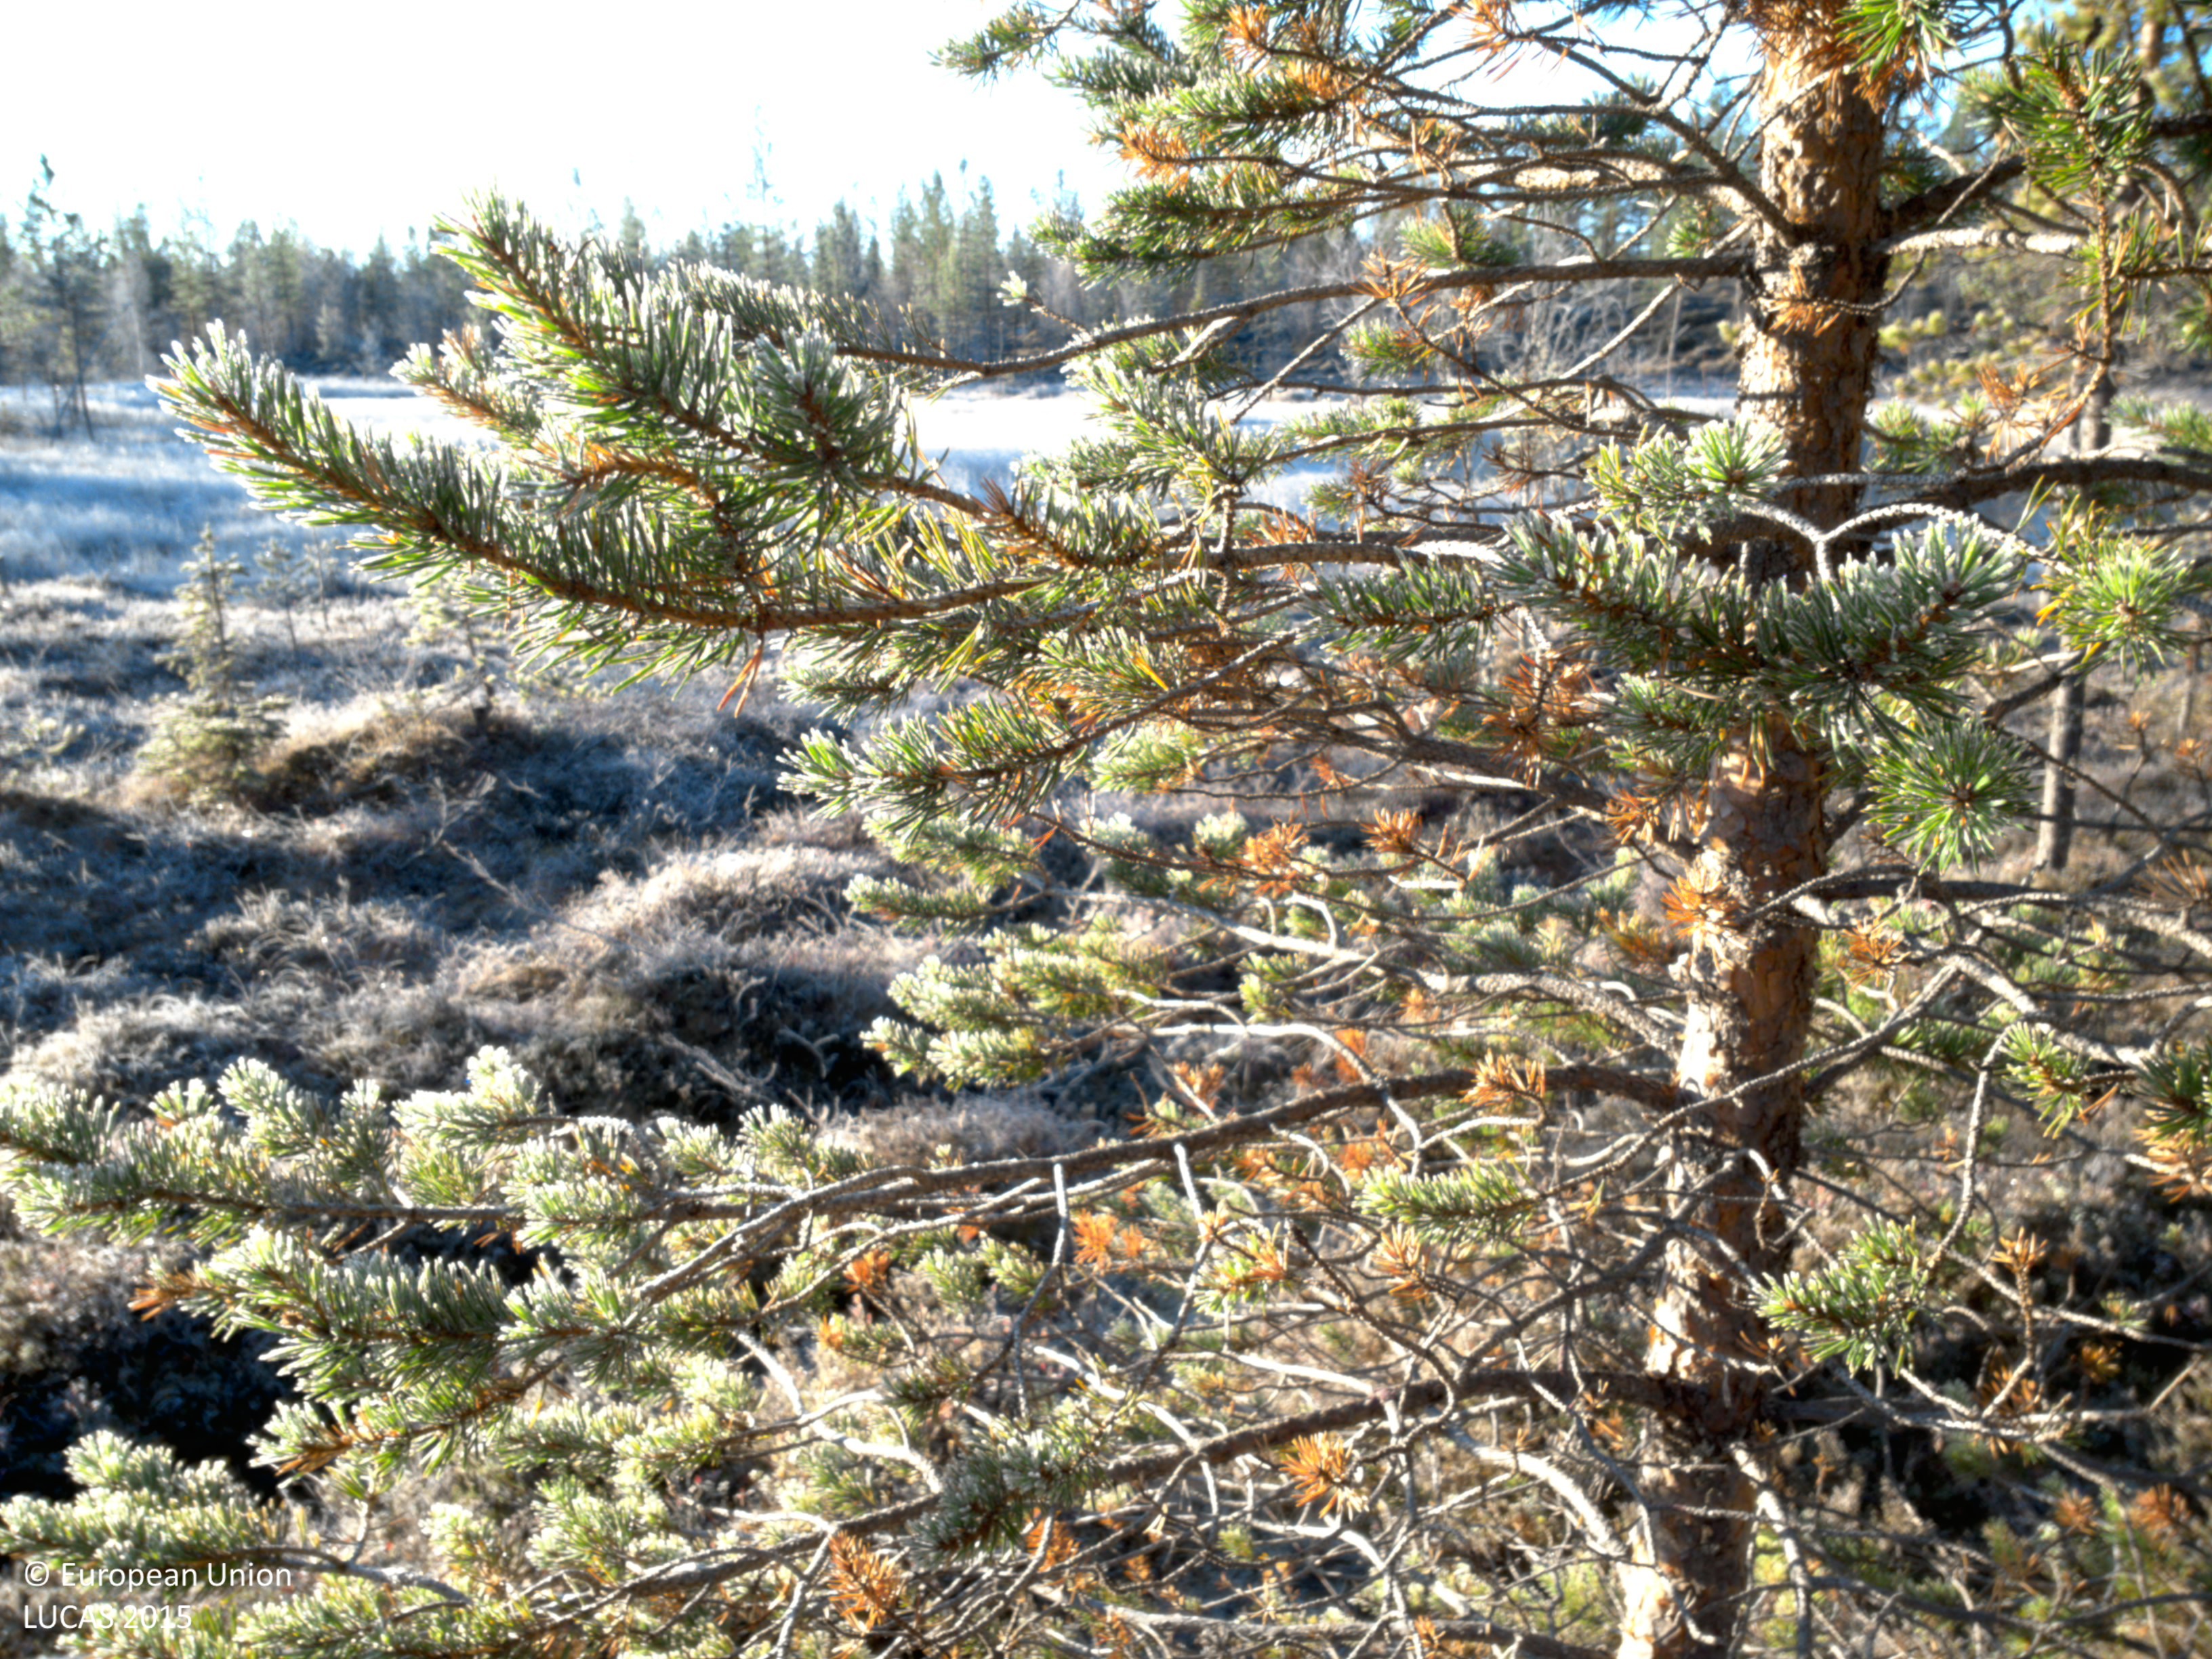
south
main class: Woodland
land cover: Pine dominated coniferous woodland
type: mire and swamp forests
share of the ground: 25 - 50 %
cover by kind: coniferous forest trees 50 %, shrubs 25 %, herbaceous plants 15 %, lichens and mosses 10 %
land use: Forestry
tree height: > 5 m
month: October
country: SE
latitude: 64.7131
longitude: 17.8340
